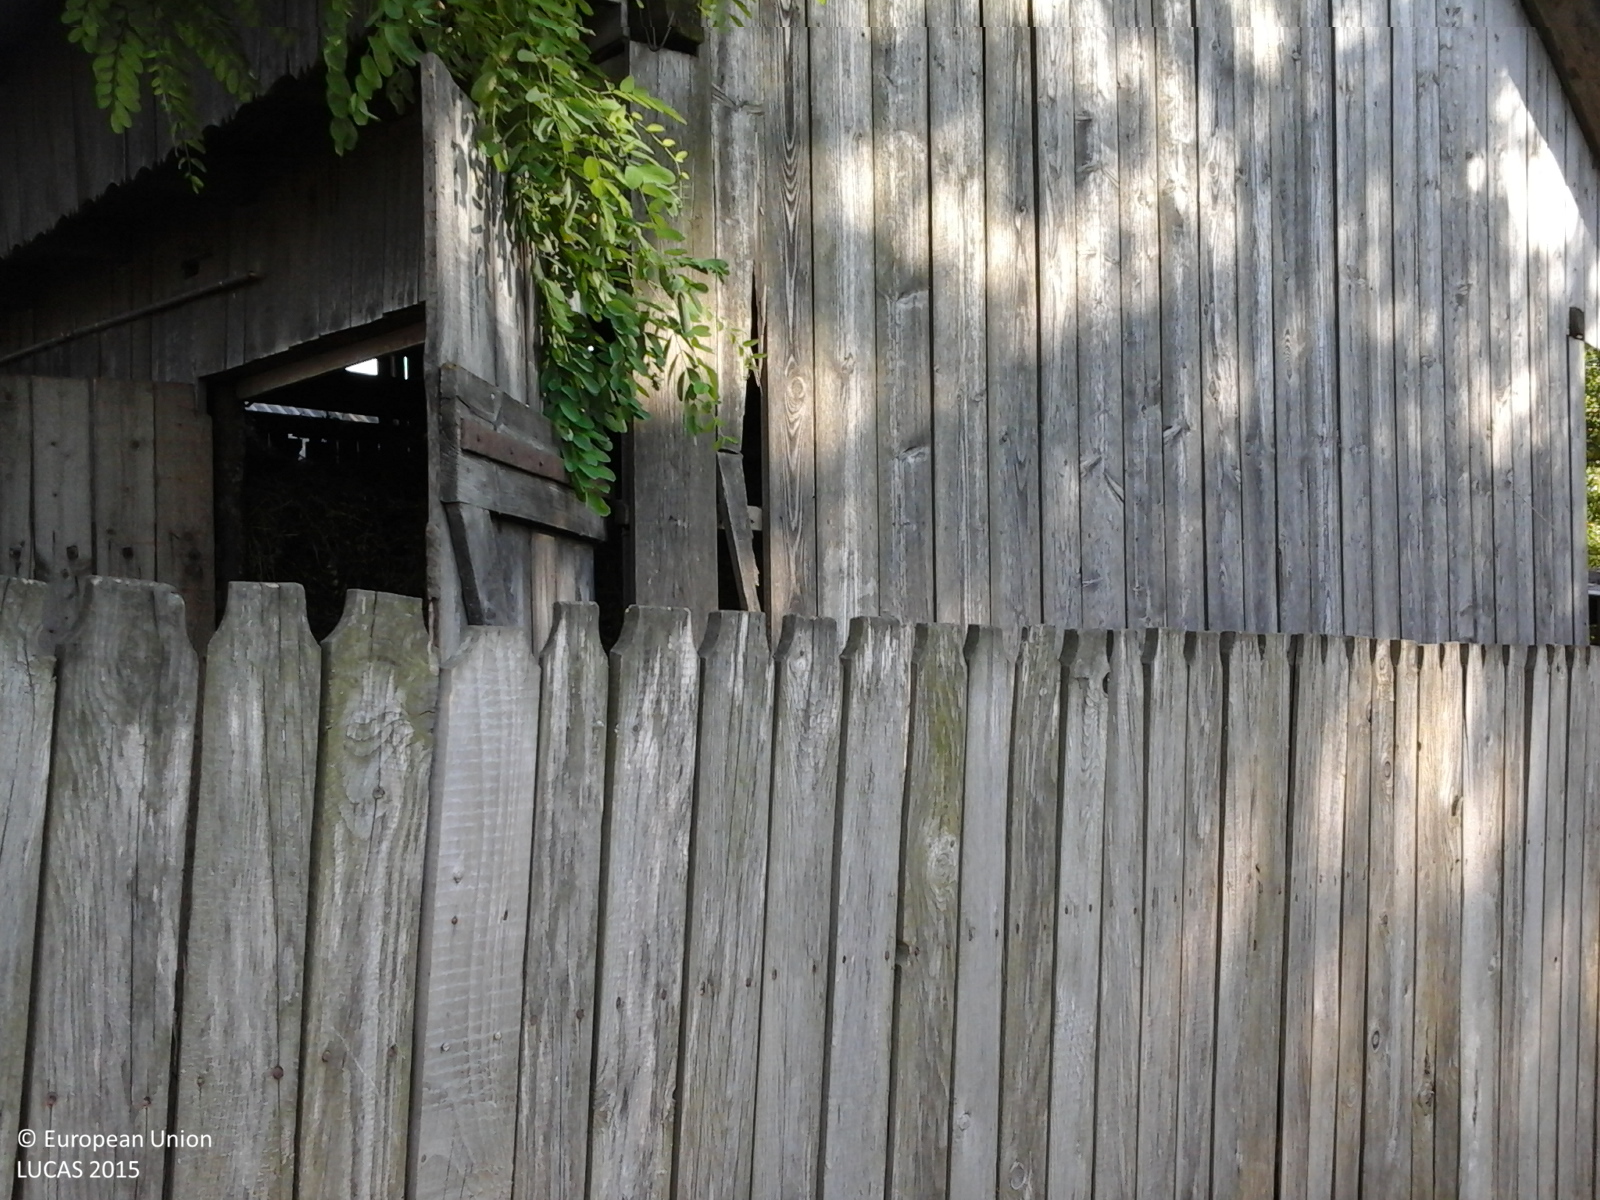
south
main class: Grassland
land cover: Grassland without tree/shrub cover
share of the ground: > 75 %
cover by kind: herbaceous plants 100 %
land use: Sport
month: June
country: RO
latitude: 47.4627
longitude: 27.0994
